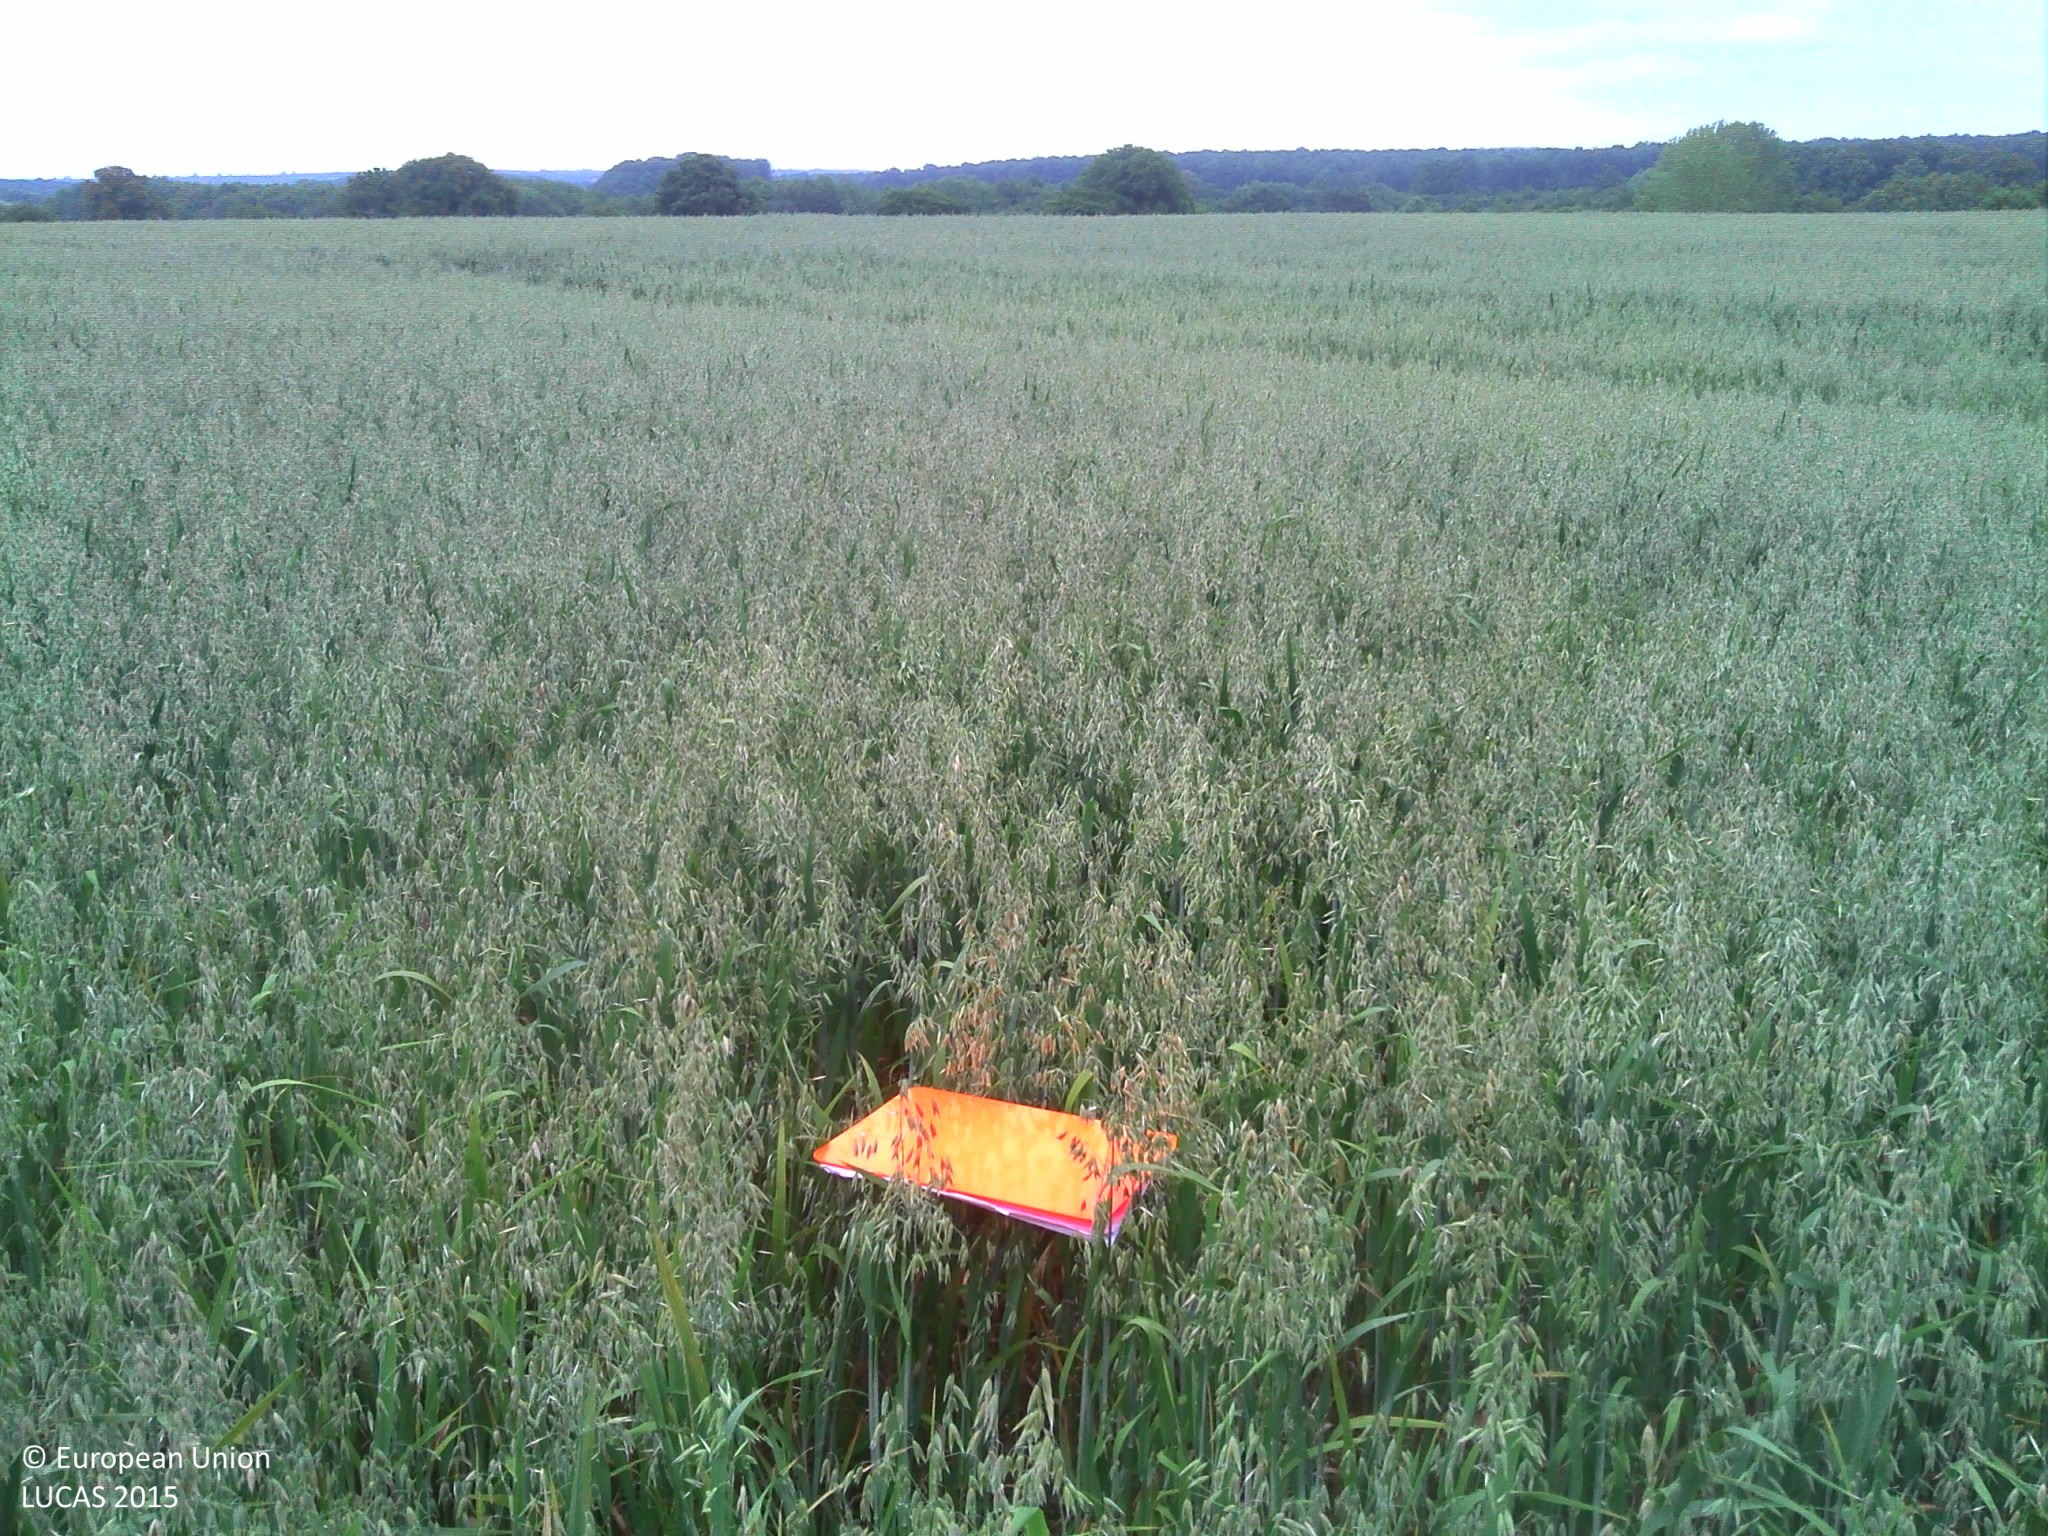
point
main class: Cropland
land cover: Oats
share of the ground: > 75 %
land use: Agriculture (excluding fallow land and kitchen gardens)
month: June
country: FR
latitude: 47.2869
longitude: 3.1332
